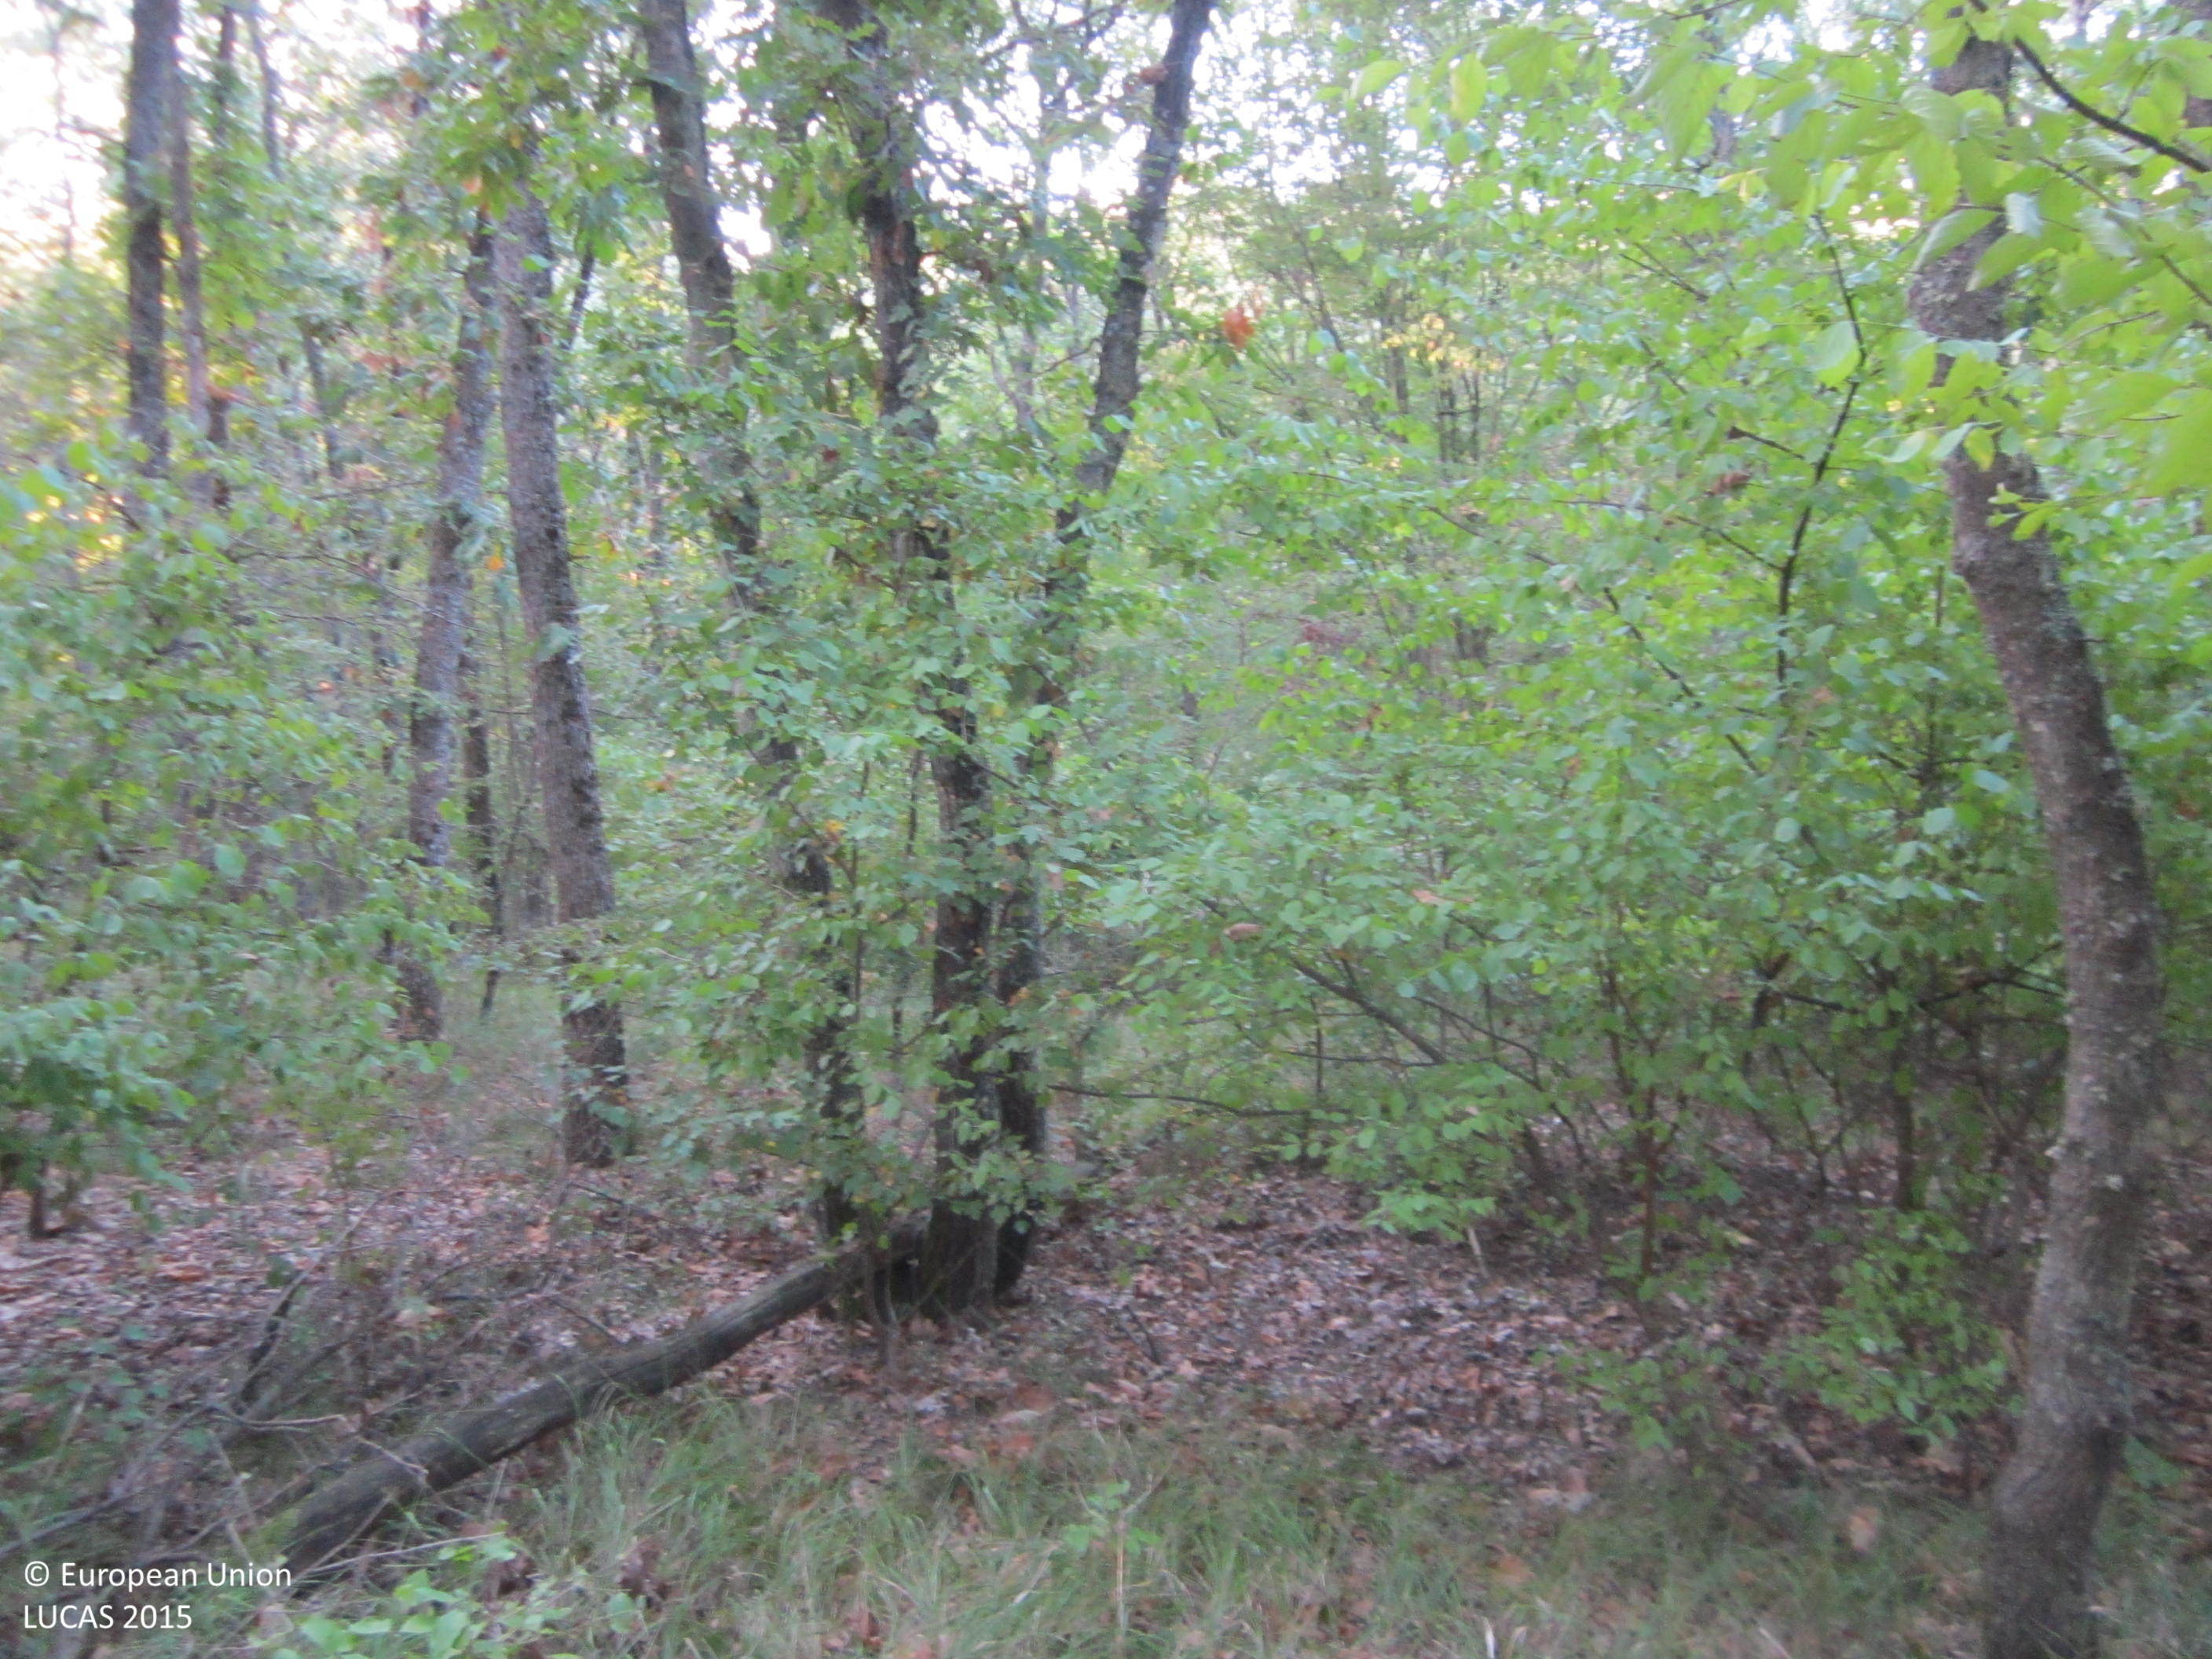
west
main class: Woodland
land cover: Broadleaved woodland
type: thermophilous deciduous forest
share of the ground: > 75 %
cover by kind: broadleaved forest trees 80 %, herbaceous plants 10 %, unconsolidated bare surface 10 %
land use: Forestry
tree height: > 5 m
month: September
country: BG
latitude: 42.2402
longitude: 27.0812
